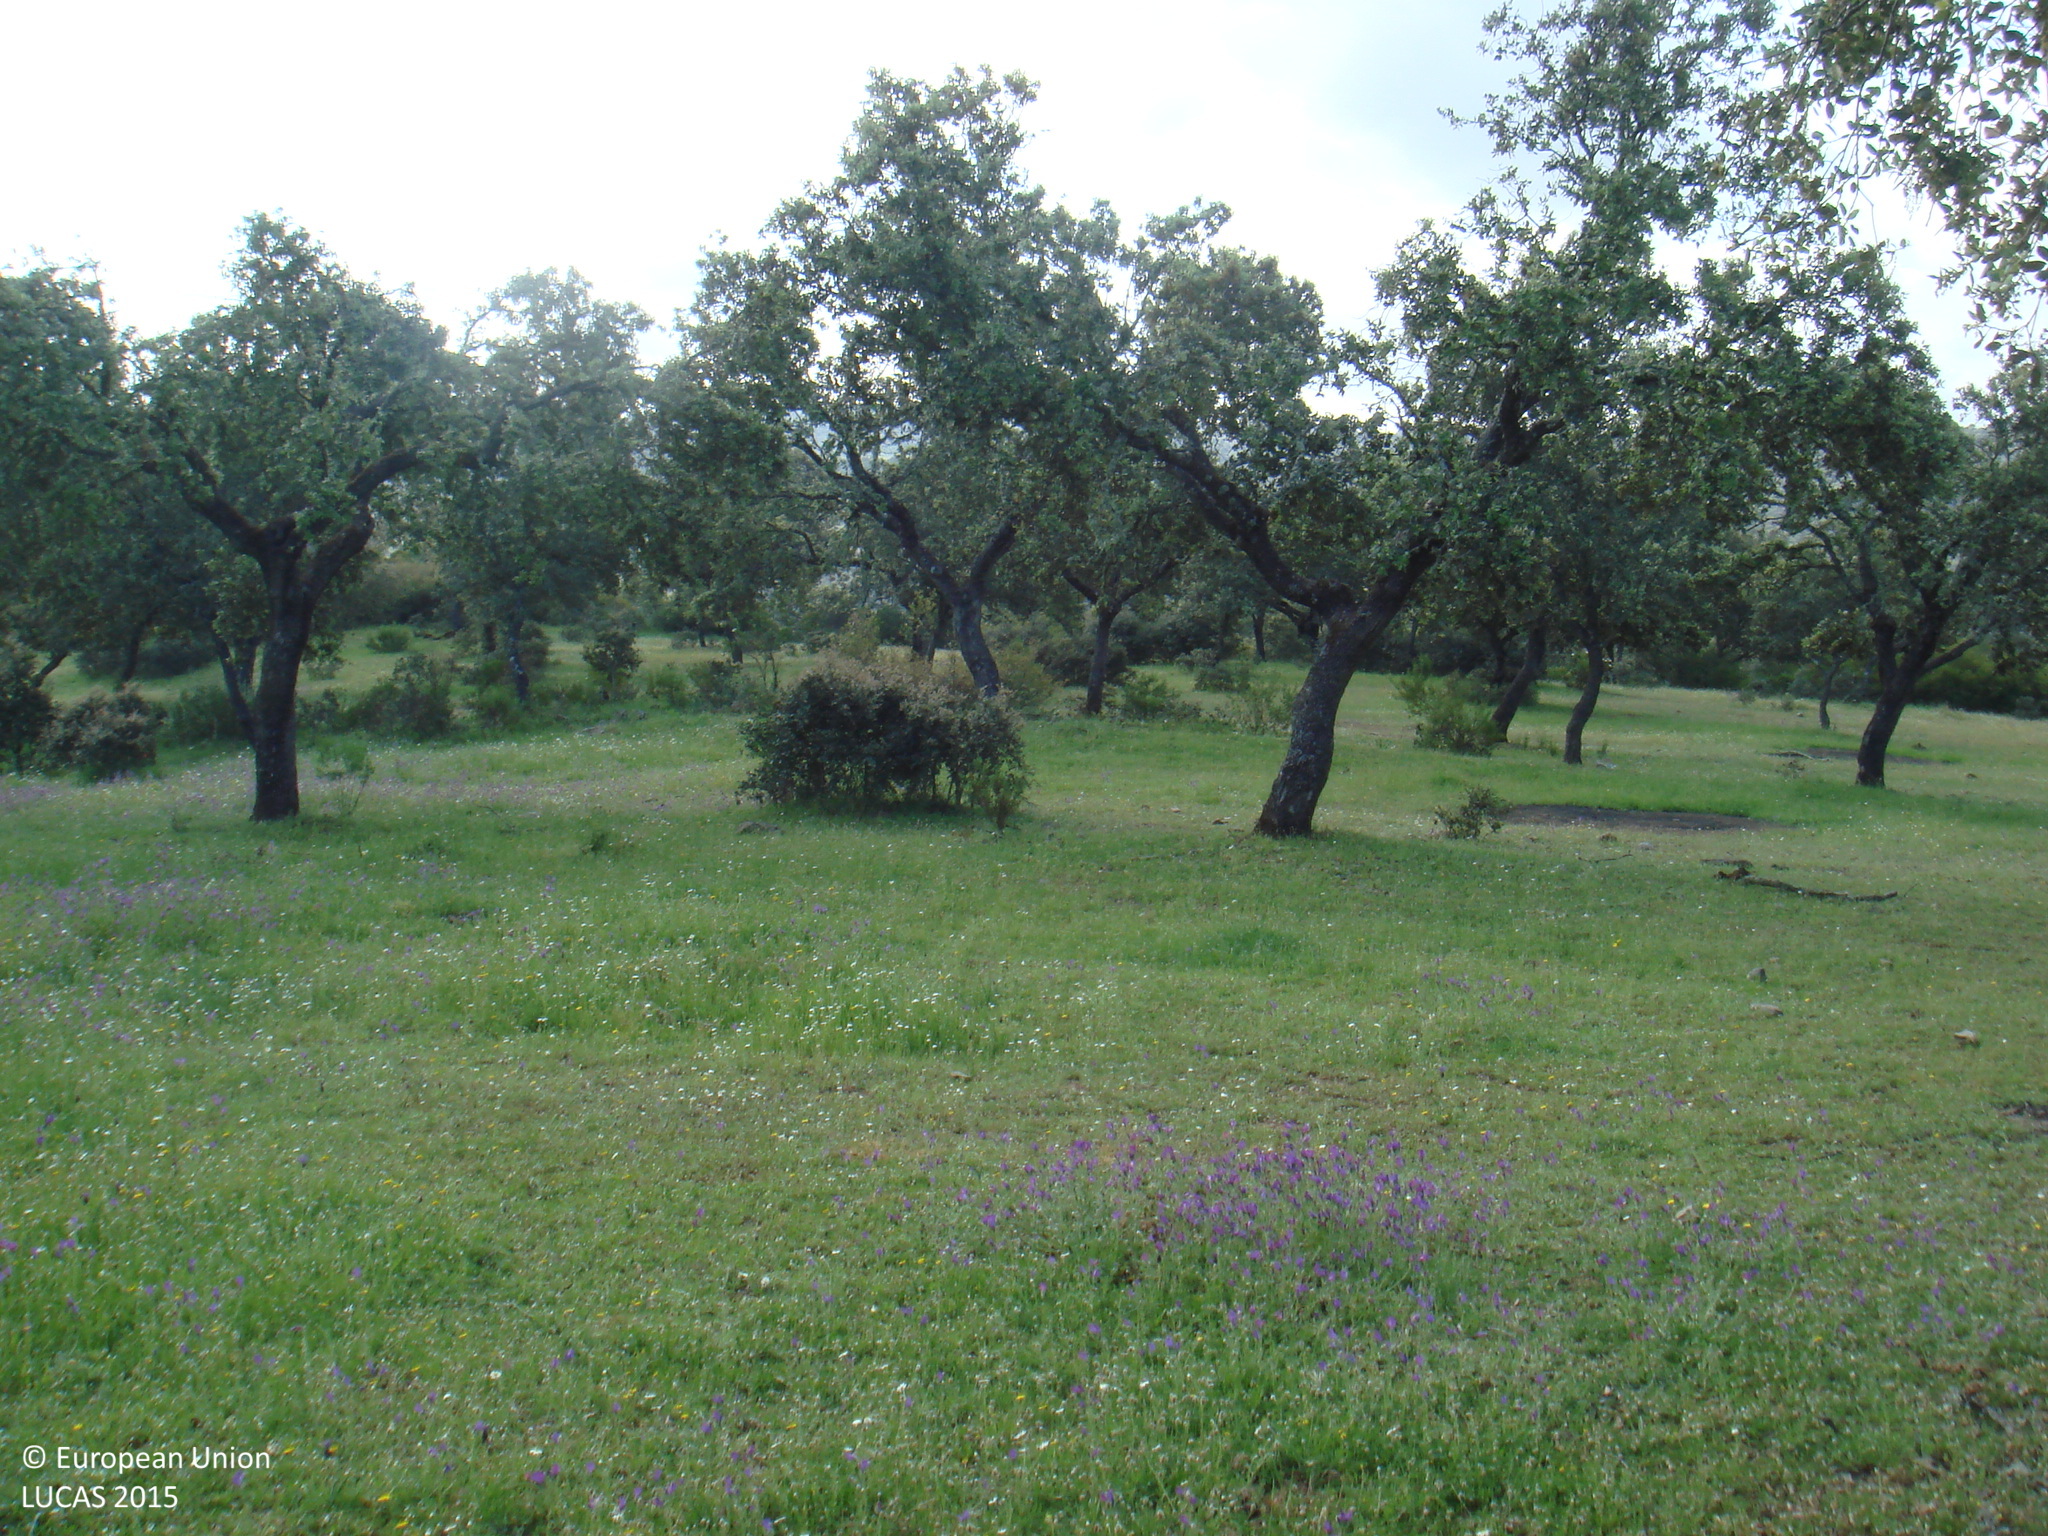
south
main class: Woodland
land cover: Broadleaved woodland
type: broadleaved evergreen forest
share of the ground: 25 - 50 %
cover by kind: herbaceous plants 60 %, broadleaved forest trees 30 %, shrubs 10 %
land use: Forestry
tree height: > 5 m
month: April
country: ES
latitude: 38.1929
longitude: -5.0842
